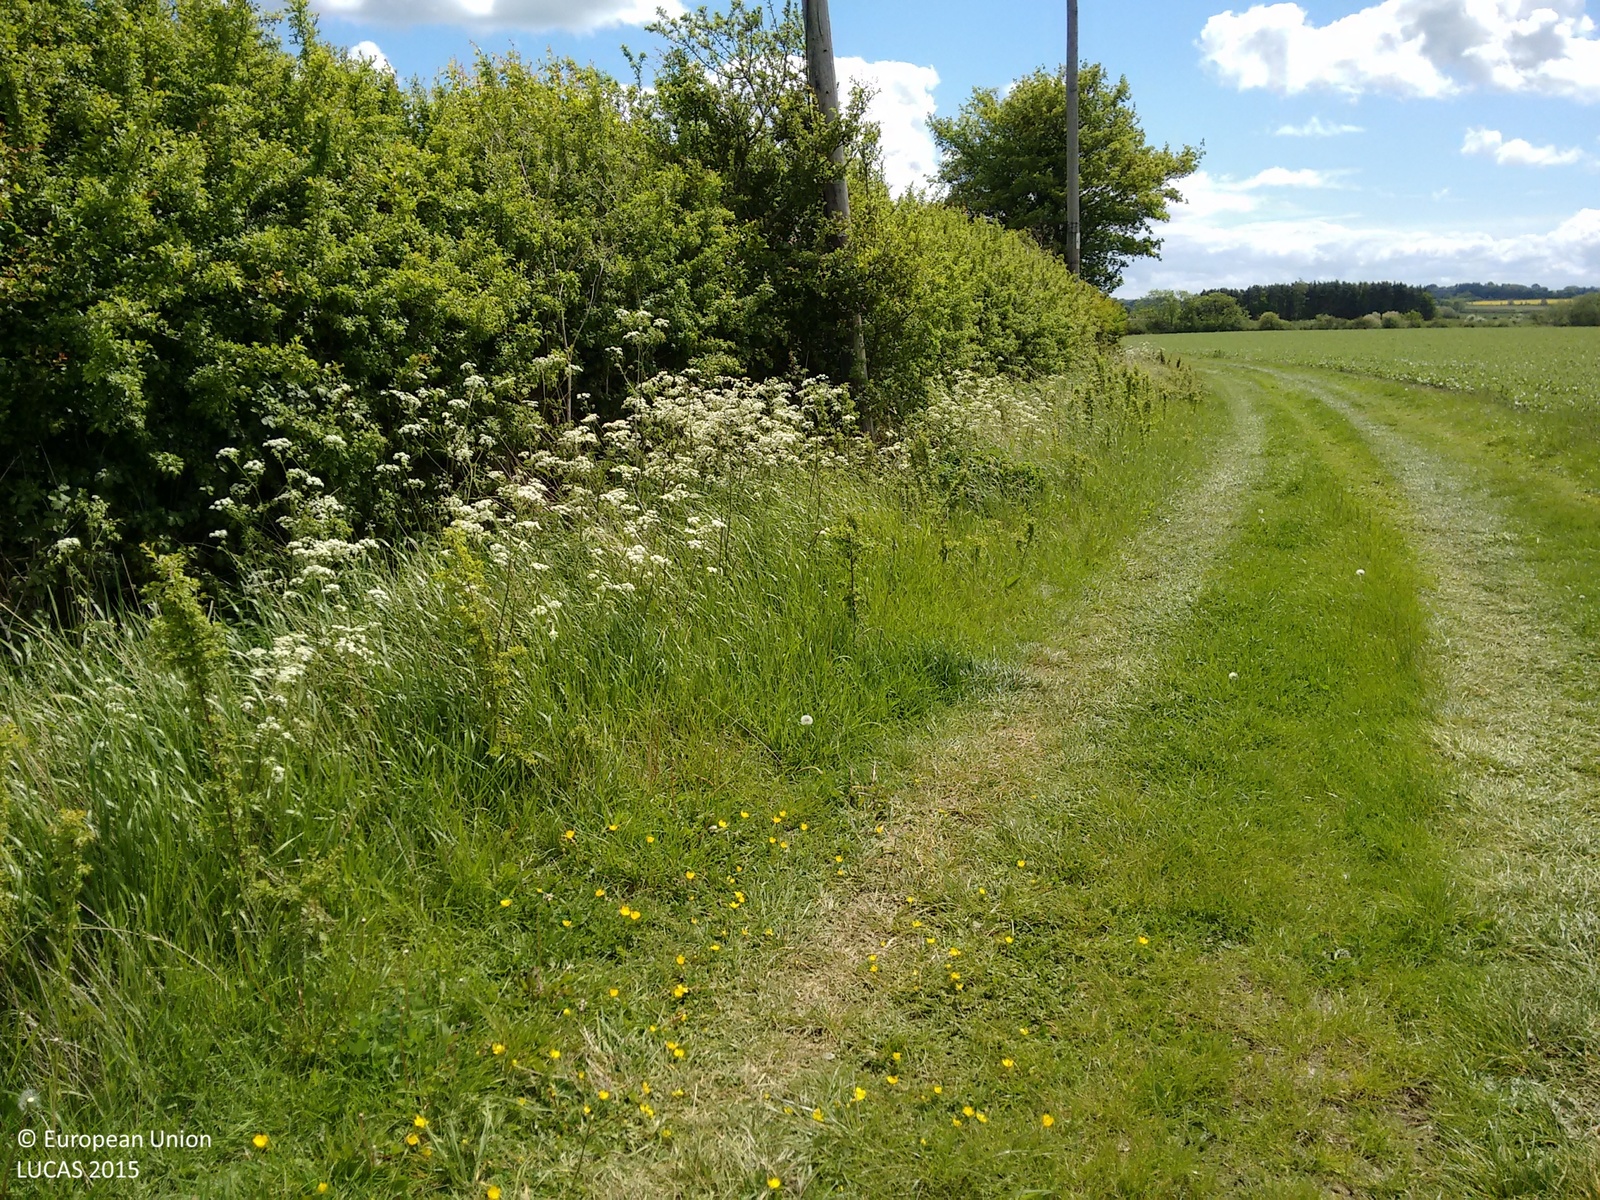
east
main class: Grassland
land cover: Grassland without tree/shrub cover
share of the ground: > 75 %
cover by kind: herbaceous plants 100 %
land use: Agriculture (excluding fallow land and kitchen gardens)
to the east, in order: Grassland without tree/shrub cover; Ditches and canals; Managed hedges; Grassland without tree/shrub cover; Common wheat; Electric lines; Common wheat; Grass margins; Tracks; Grass margins; Other fresh vegetables
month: May
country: GB
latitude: 52.2113
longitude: -1.3620
